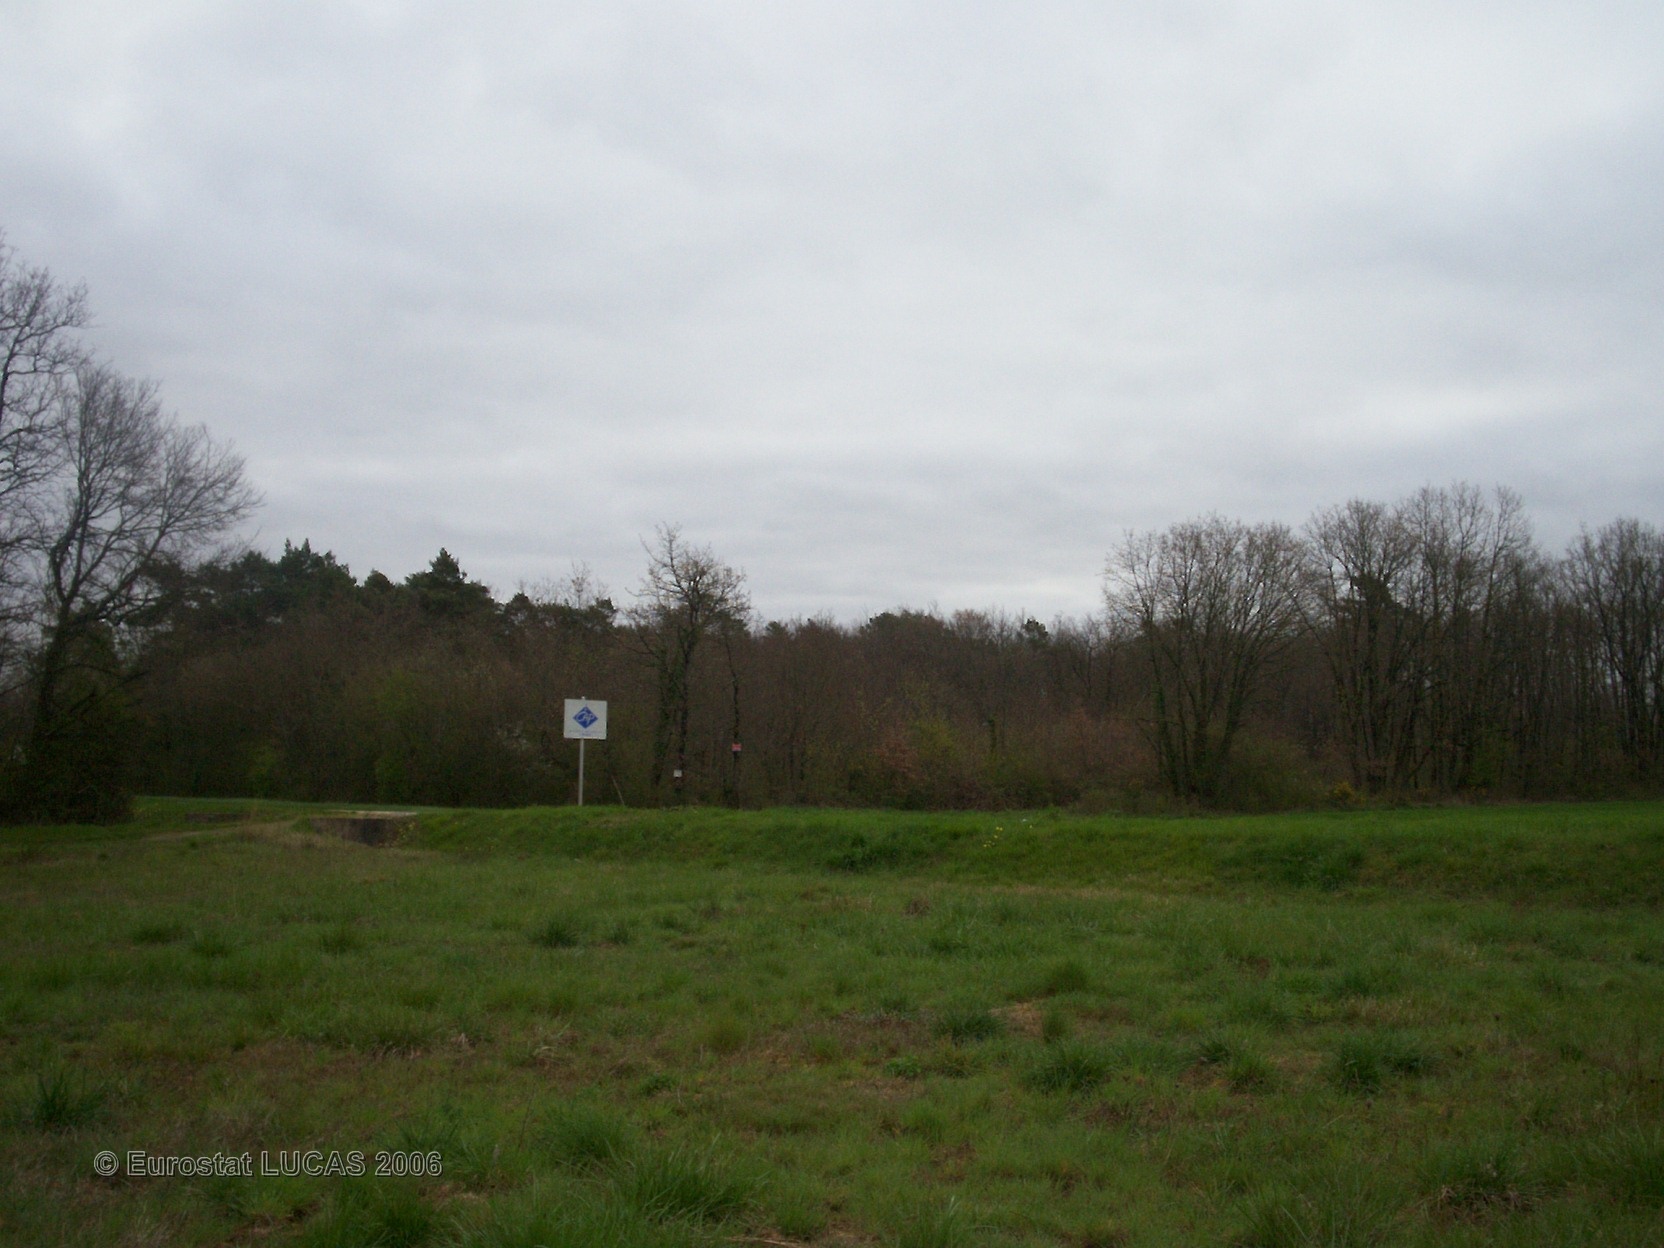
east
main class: Grassland
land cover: Grassland without tree/shrub cover
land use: Agriculture (excluding fallow land and kitchen gardens)
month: April
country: FR
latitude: 46.5348
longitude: 0.3982
